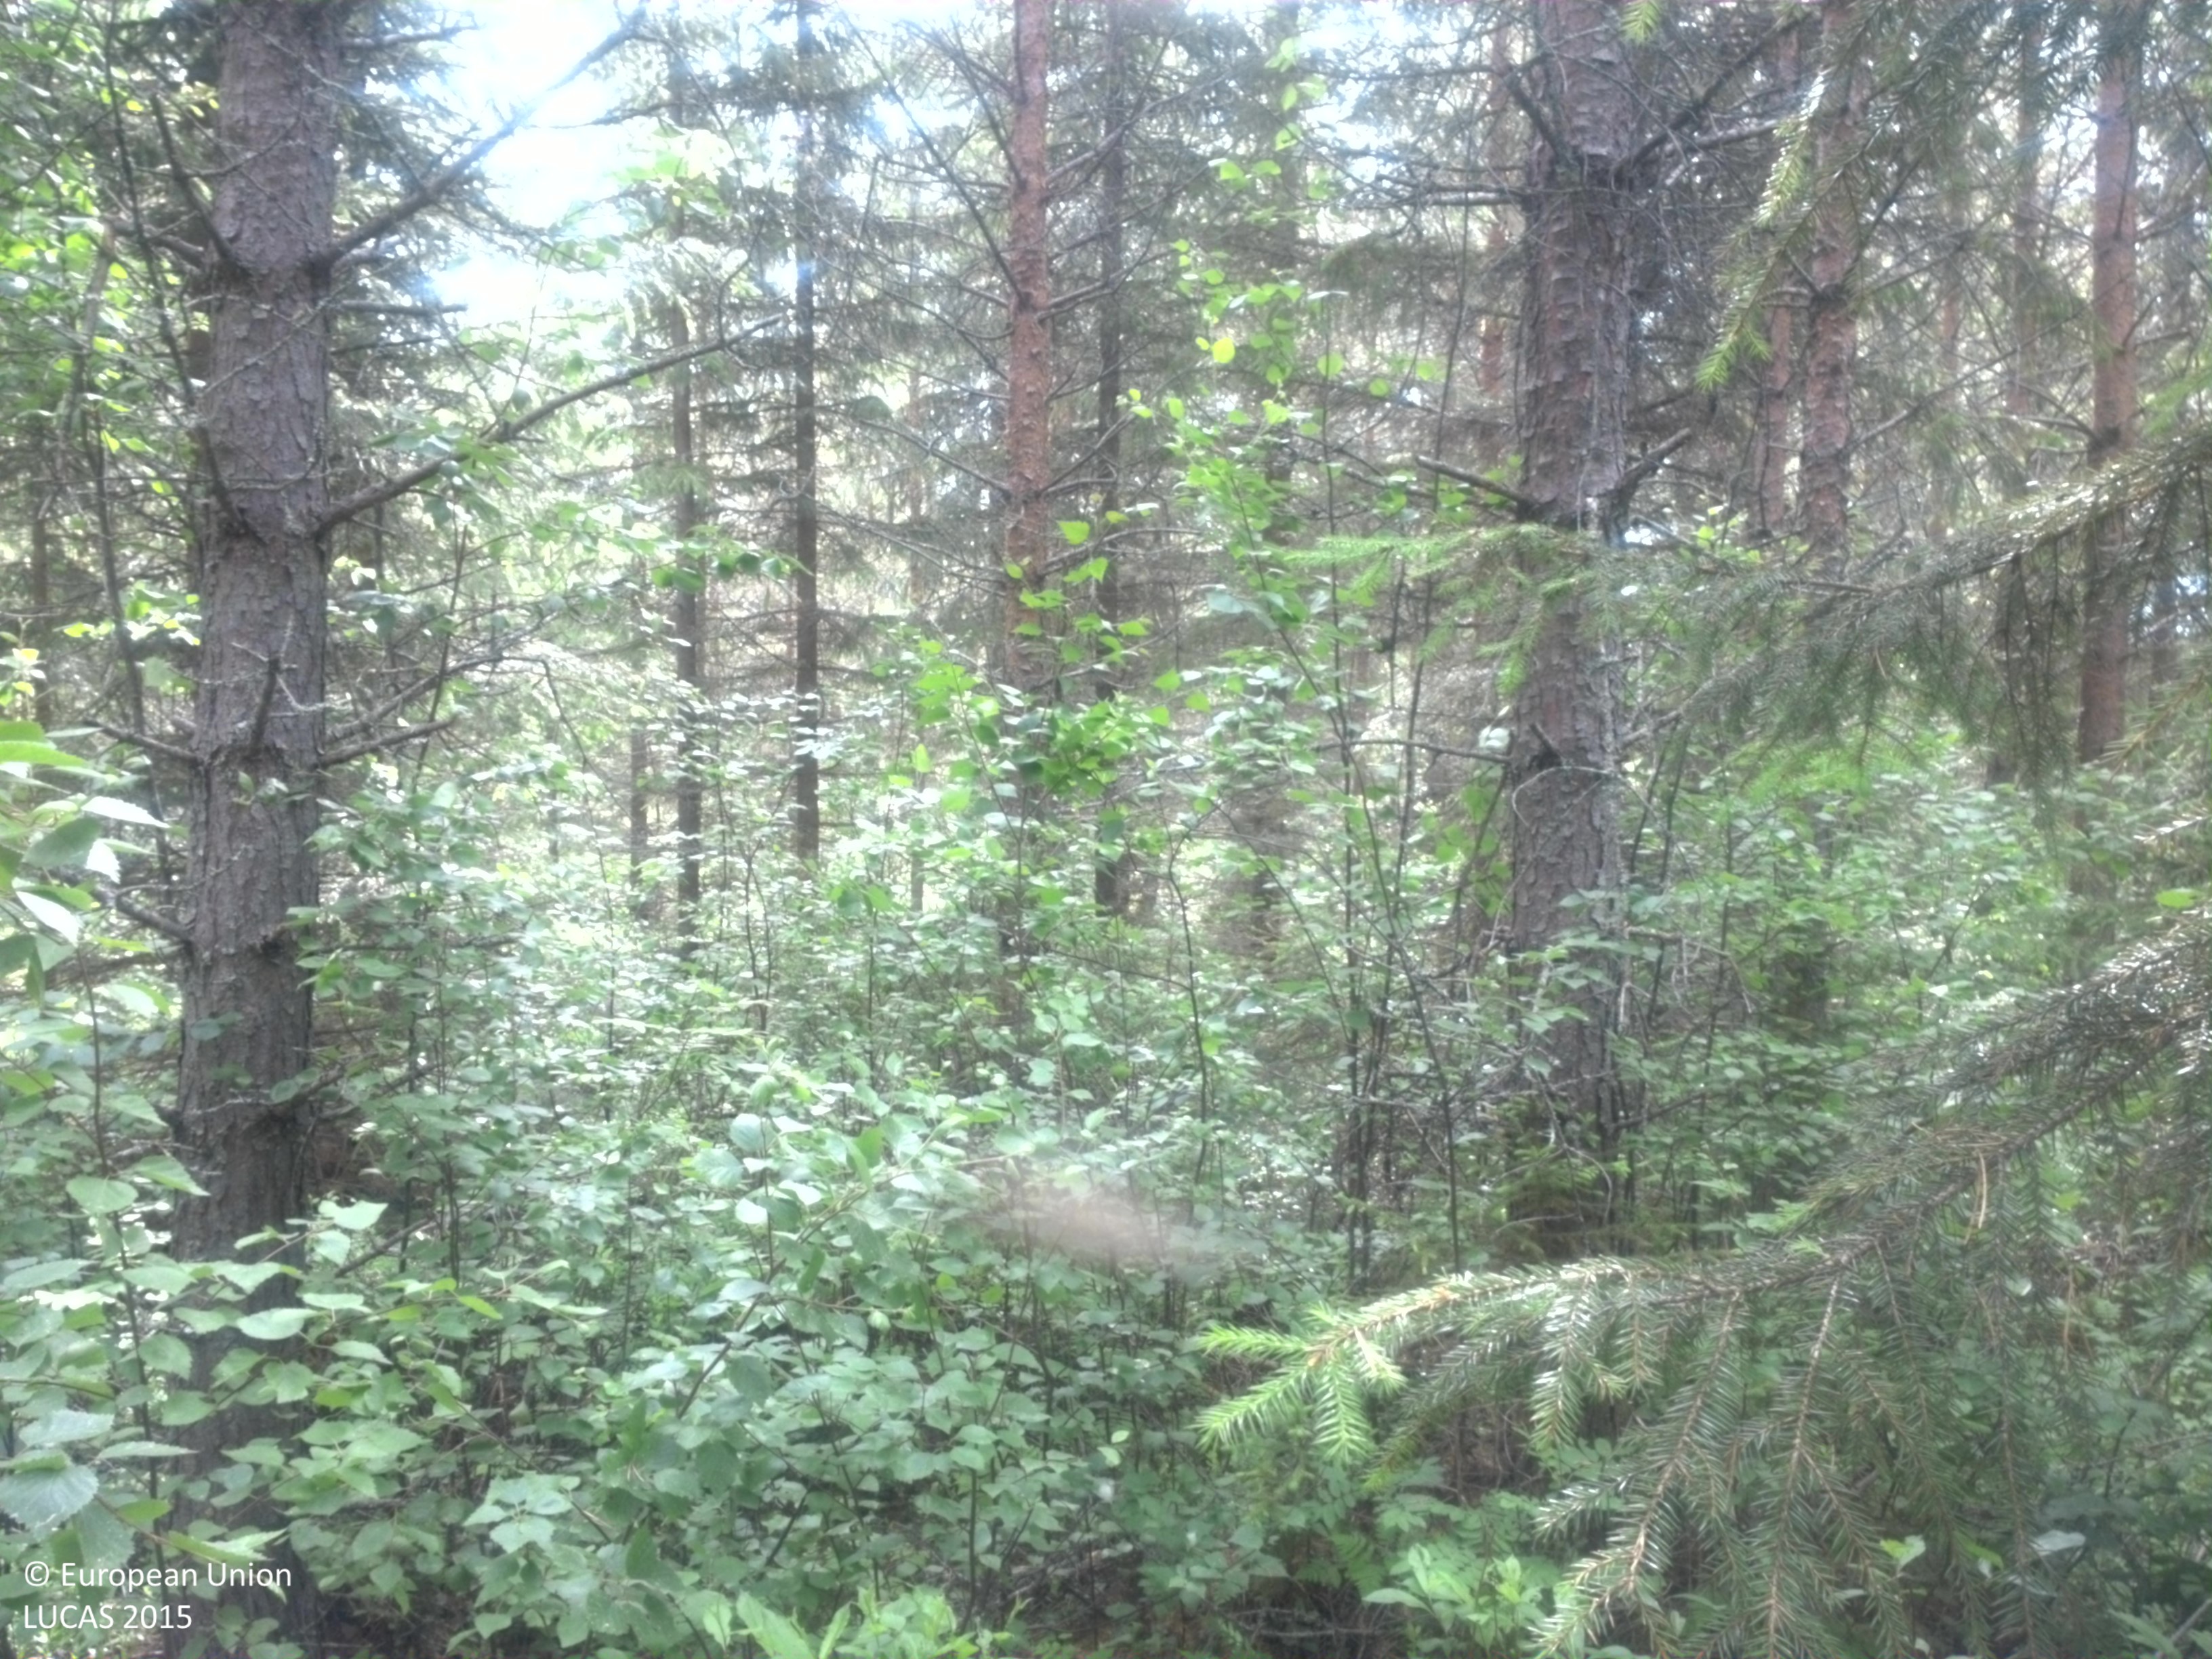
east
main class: Woodland
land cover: Other coniferous woodland
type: boreal forest
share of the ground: > 75 %
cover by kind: coniferous forest trees 80 %, shrubs 15 %, broadleaved forest trees 5 %
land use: Forestry
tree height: > 5 m
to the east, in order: Other coniferous woodland; Ditches and canals; Abandoned hedges; Other bare soil; Grassland without tree/shrub cover; Other bare soil; Spruce dominated coniferous woodland; Ditches and canals; Spruce dominated coniferous woodland; Other mixed woodland; Ditches and canals; Other mixed woodland; Ditches and canals; Other mixed woodland; Ditches and canals; Pine dominated mixed woodland
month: July
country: SE
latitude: 64.5361
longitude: 20.5880
